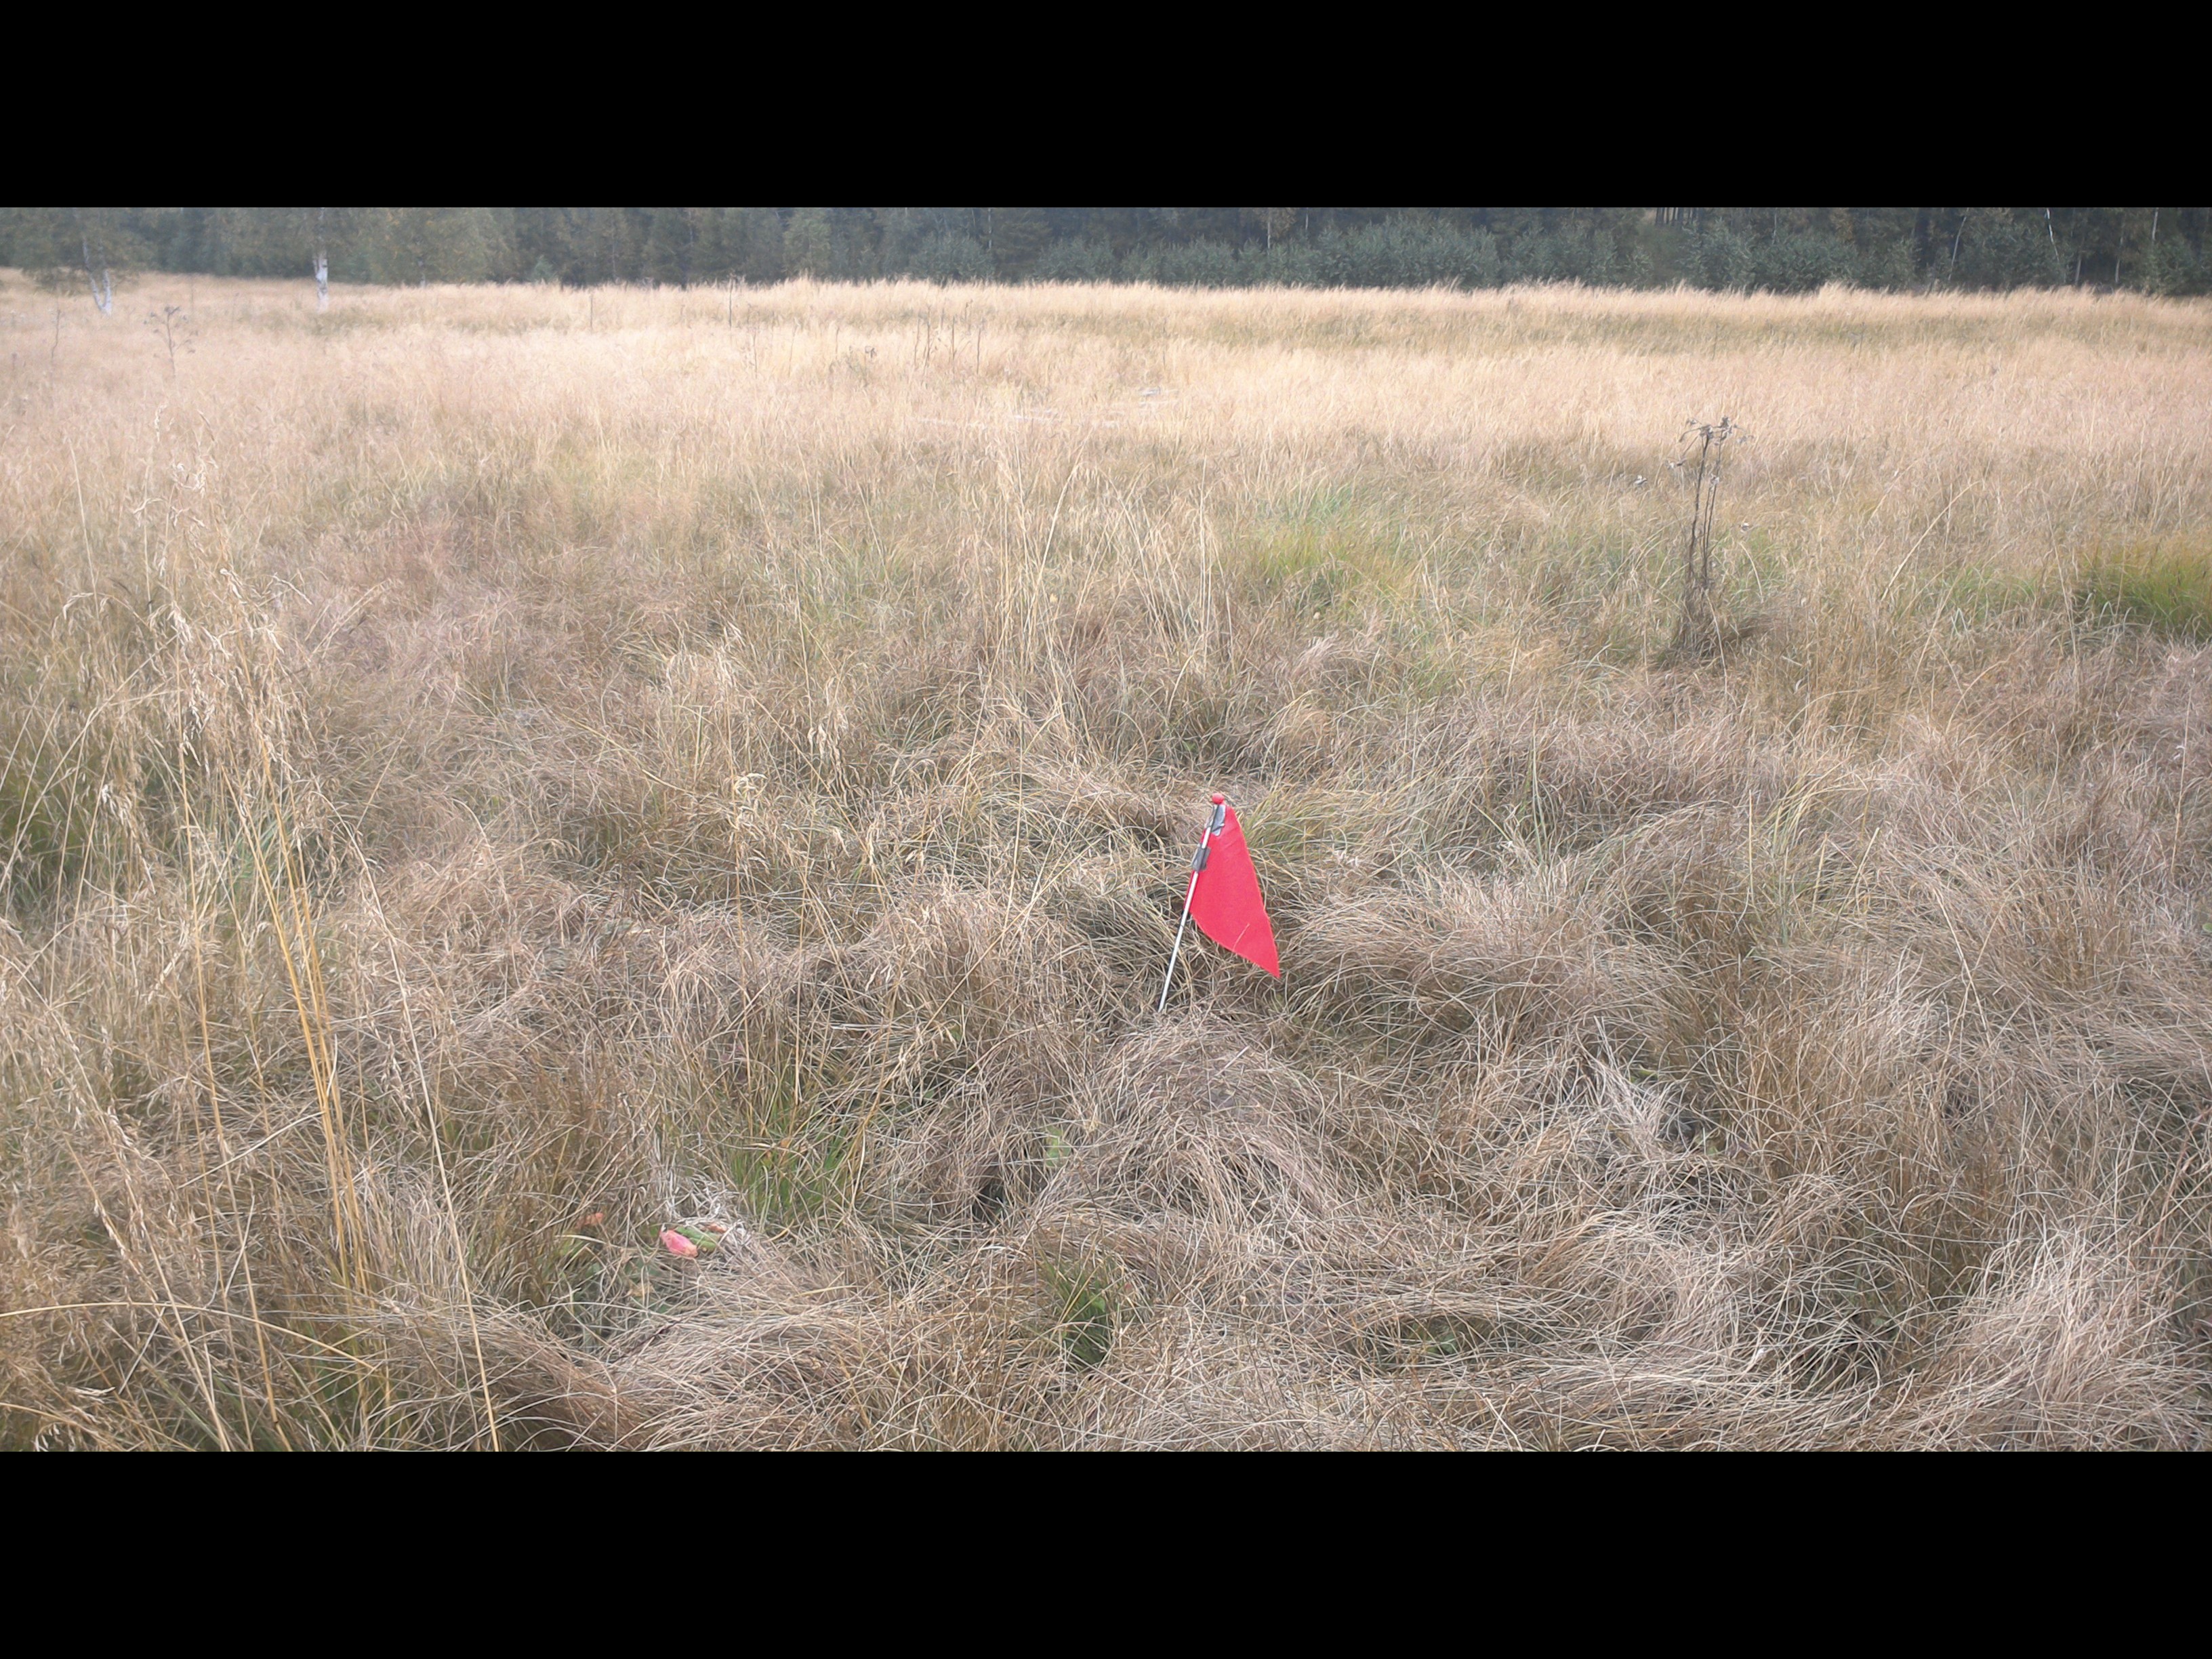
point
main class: Grassland
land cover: Grassland without tree/shrub cover
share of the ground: > 75 %
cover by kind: herbaceous plants 100 %
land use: Agriculture (excluding fallow land and kitchen gardens)
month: September
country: SE
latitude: 63.7807
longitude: 19.5739
